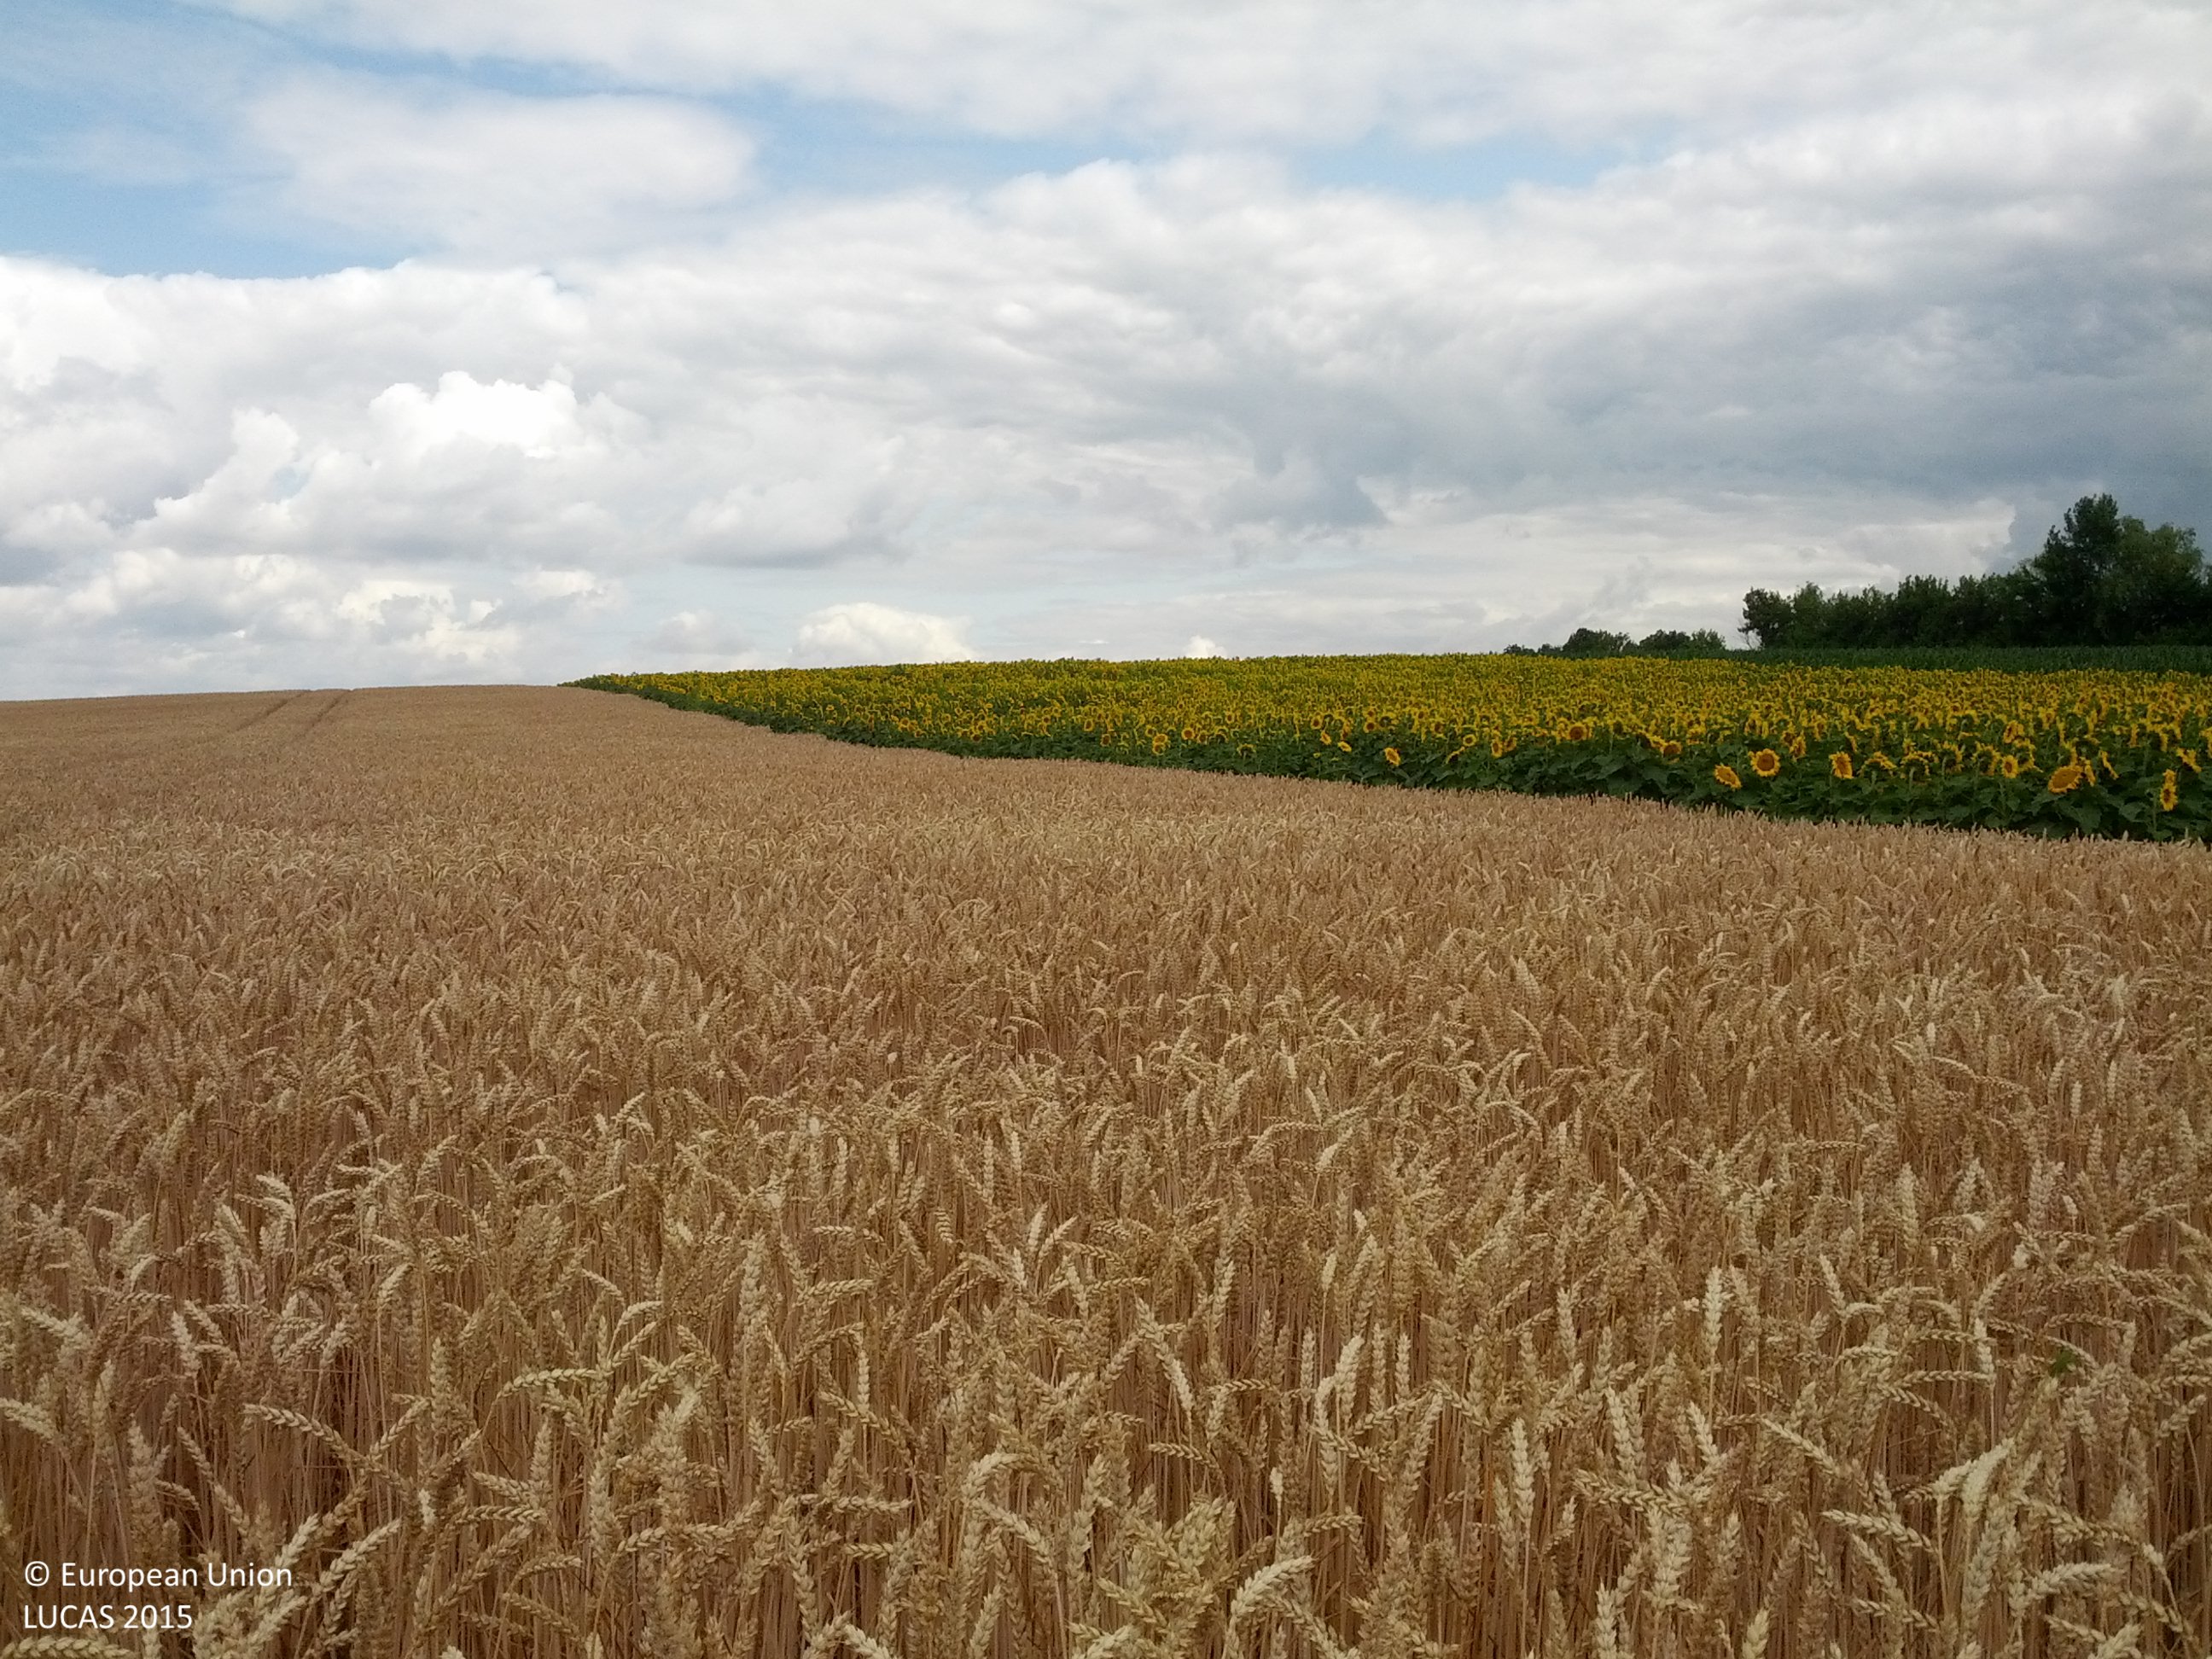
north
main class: Cropland
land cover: Common wheat
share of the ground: > 75 %
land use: Agriculture (excluding fallow land and kitchen gardens)
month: July
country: AT
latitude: 48.7166
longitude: 16.5169
